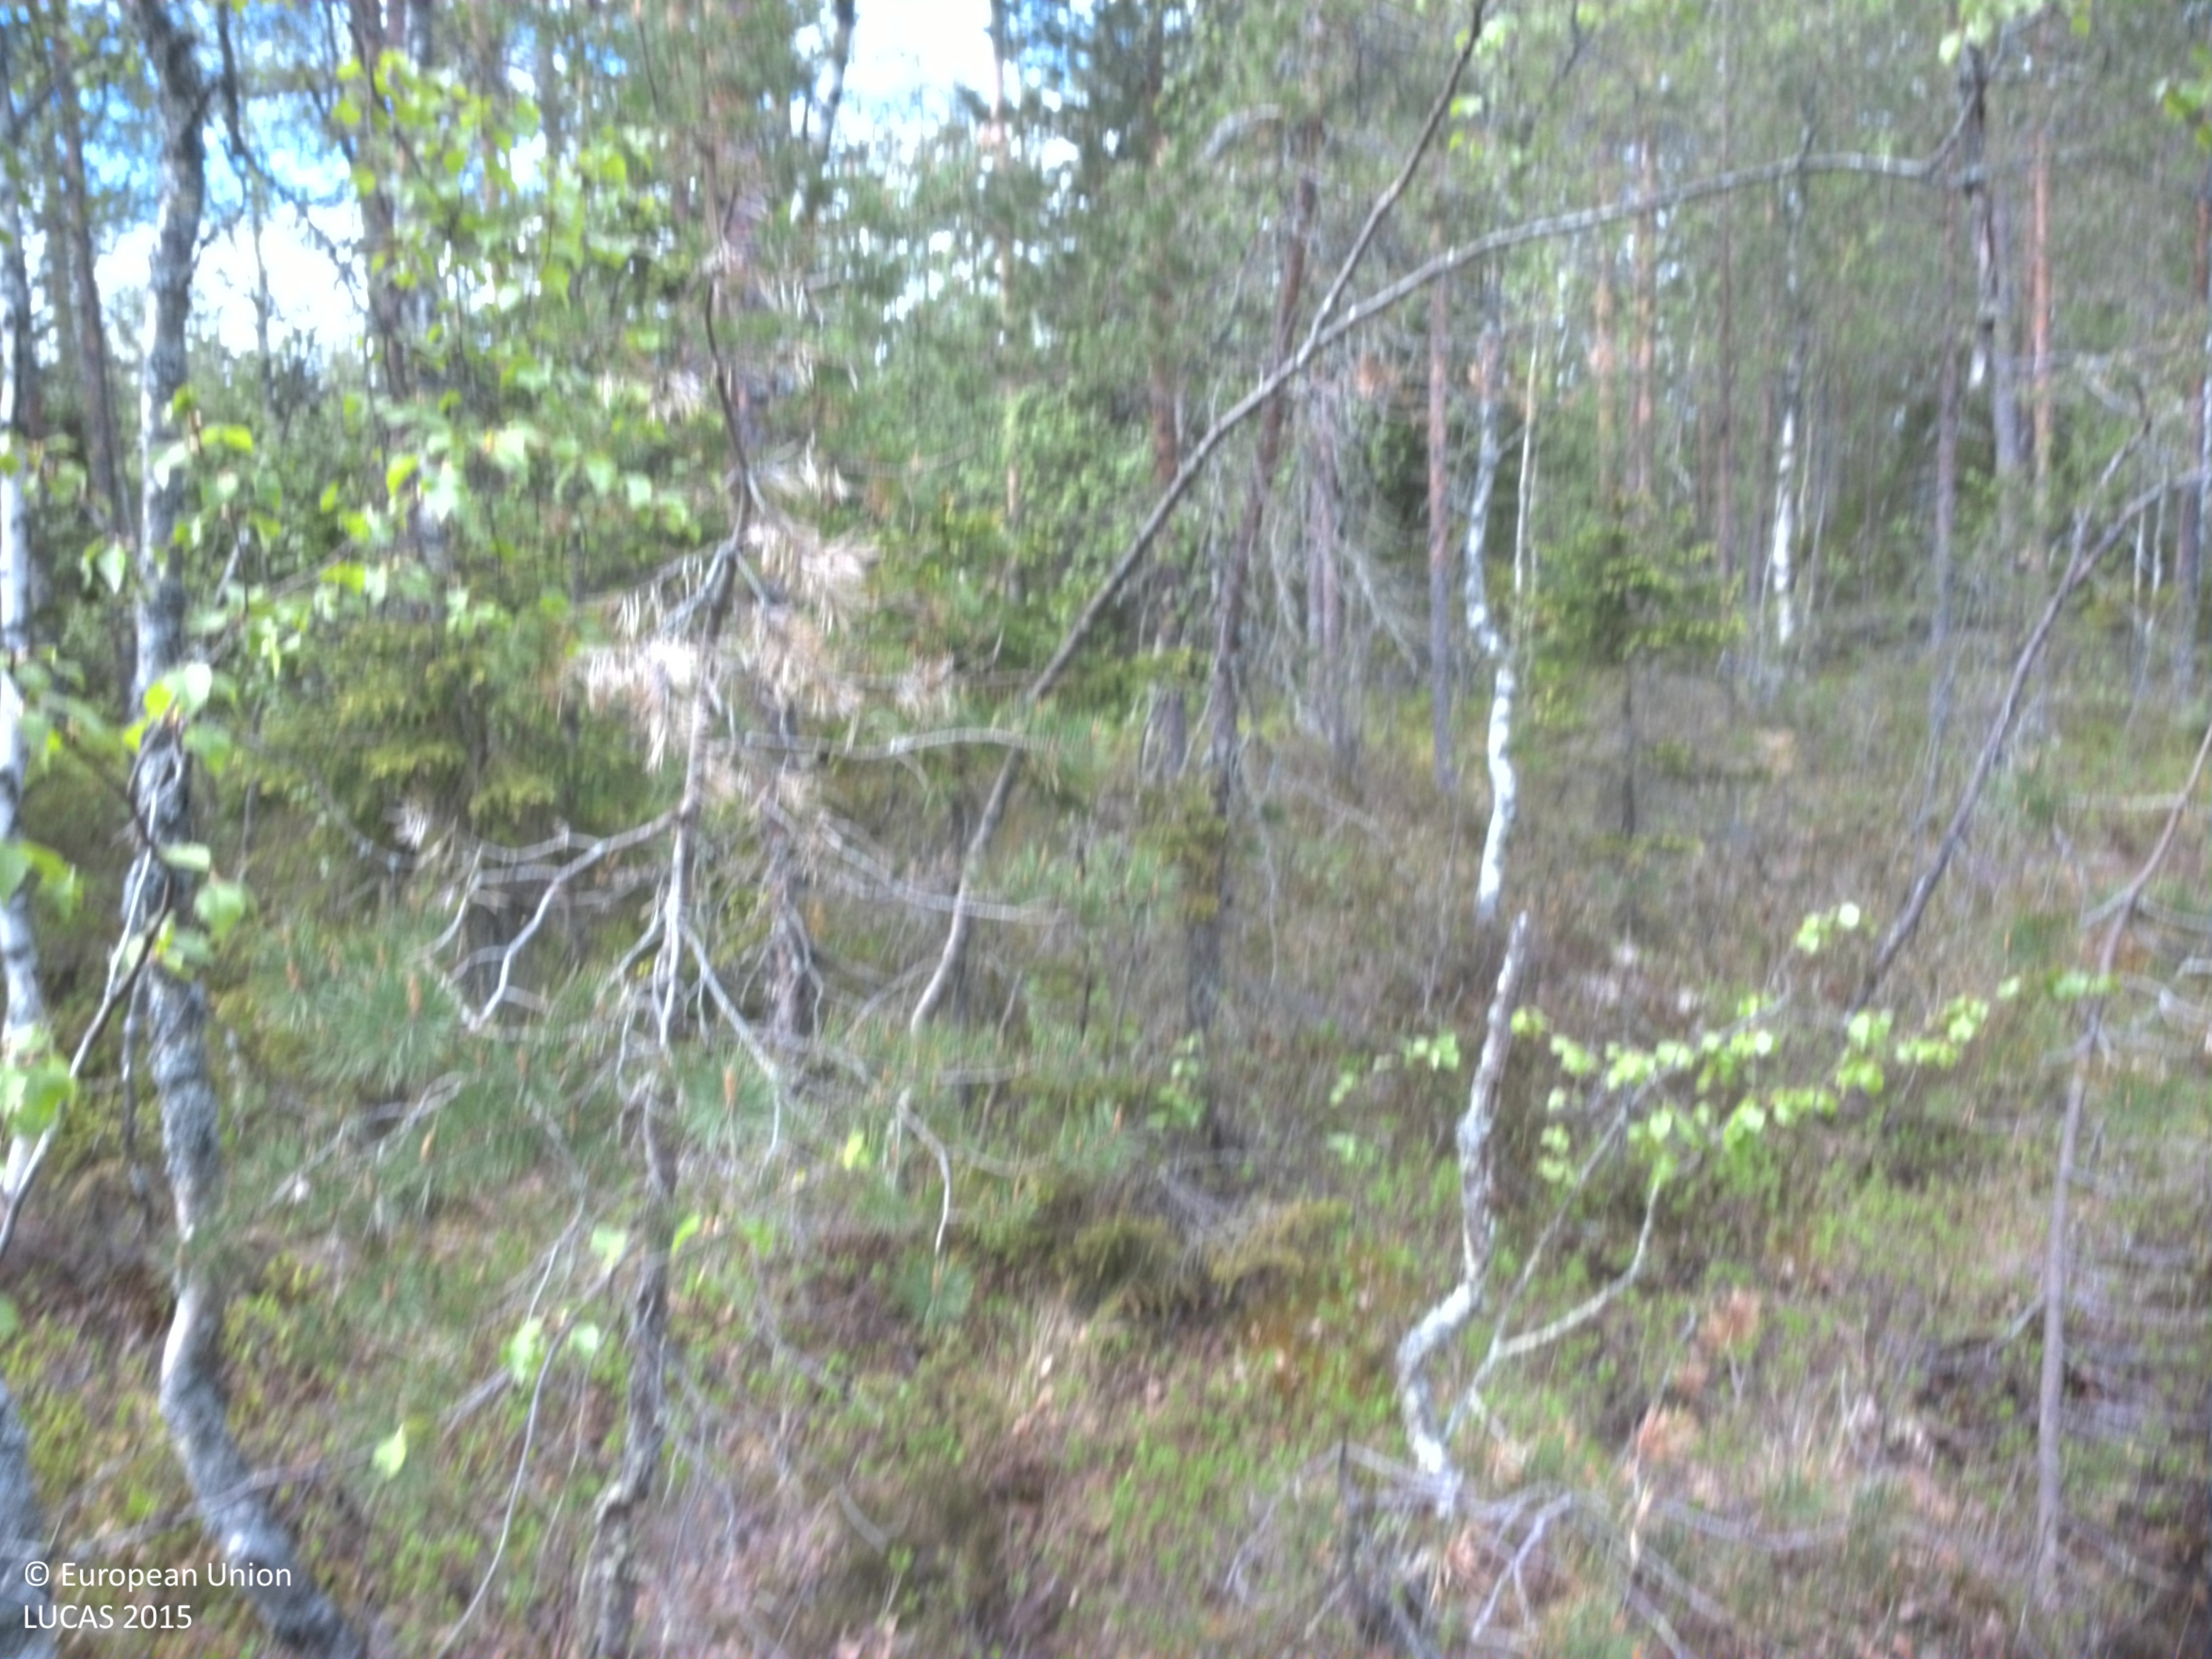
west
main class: Woodland
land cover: Pine dominated mixed woodland
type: mire and swamp forests
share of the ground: 25 - 50 %
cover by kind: shrubs 40 %, coniferous forest trees 30 %, herbaceous plants 15 %, broadleaved forest trees 10 %, lichens and mosses 5 %
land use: Semi-natural and natural areas not in use
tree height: > 5 m
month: June
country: SE
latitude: 63.9555
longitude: 20.5363
